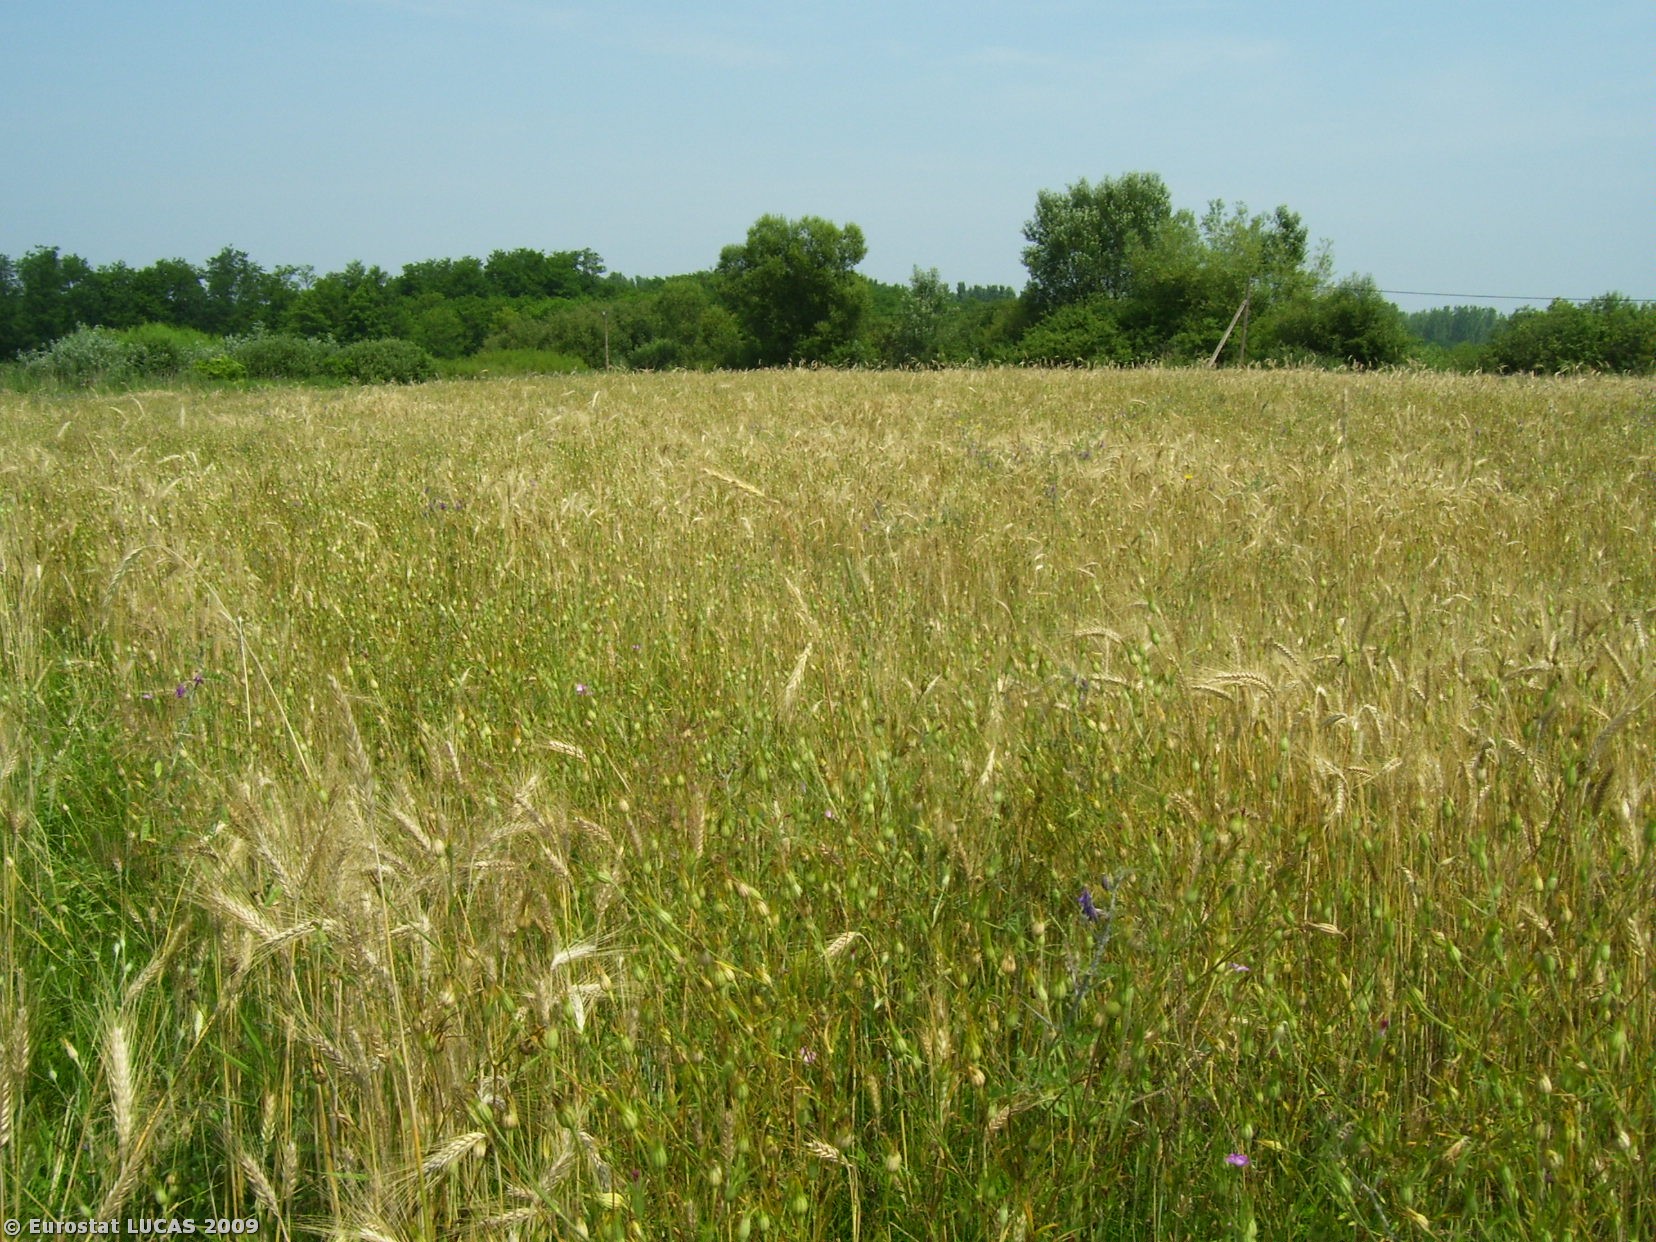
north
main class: Cropland
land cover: Triticale
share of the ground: 50 - 75 %
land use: Agriculture (excluding fallow land and kitchen gardens)
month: July
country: HU
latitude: 47.6211
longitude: 21.8233
